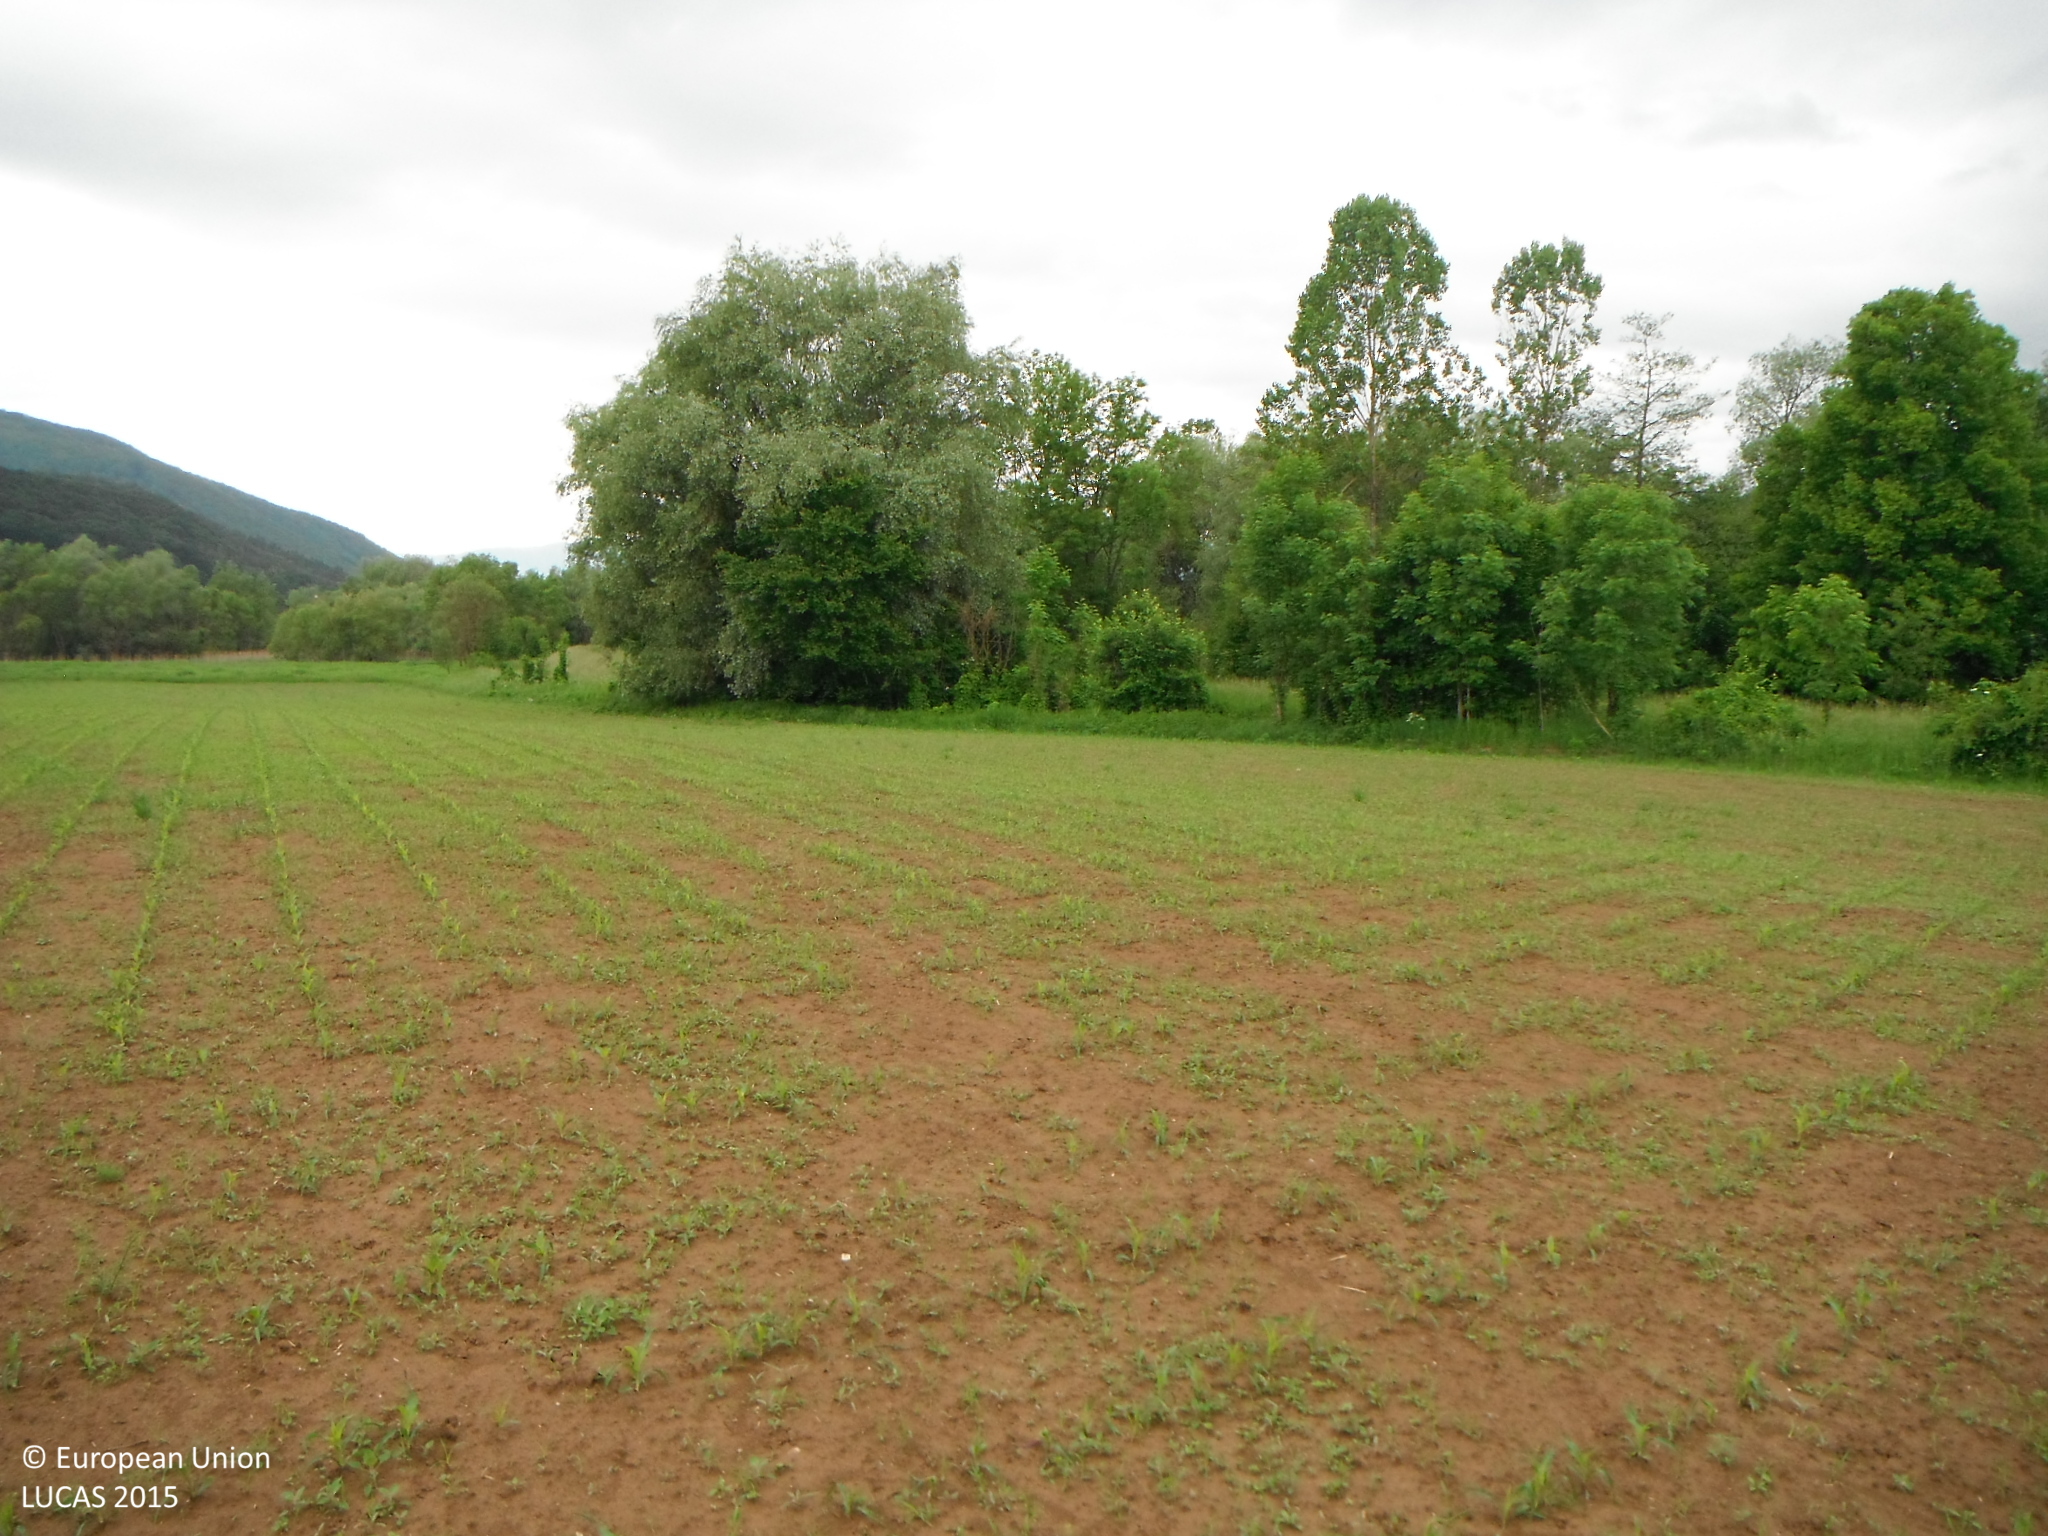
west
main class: Cropland
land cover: Maize
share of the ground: < 10 %
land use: Agriculture (excluding fallow land and kitchen gardens)
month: May
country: SK
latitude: 48.7411
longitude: 19.2291
